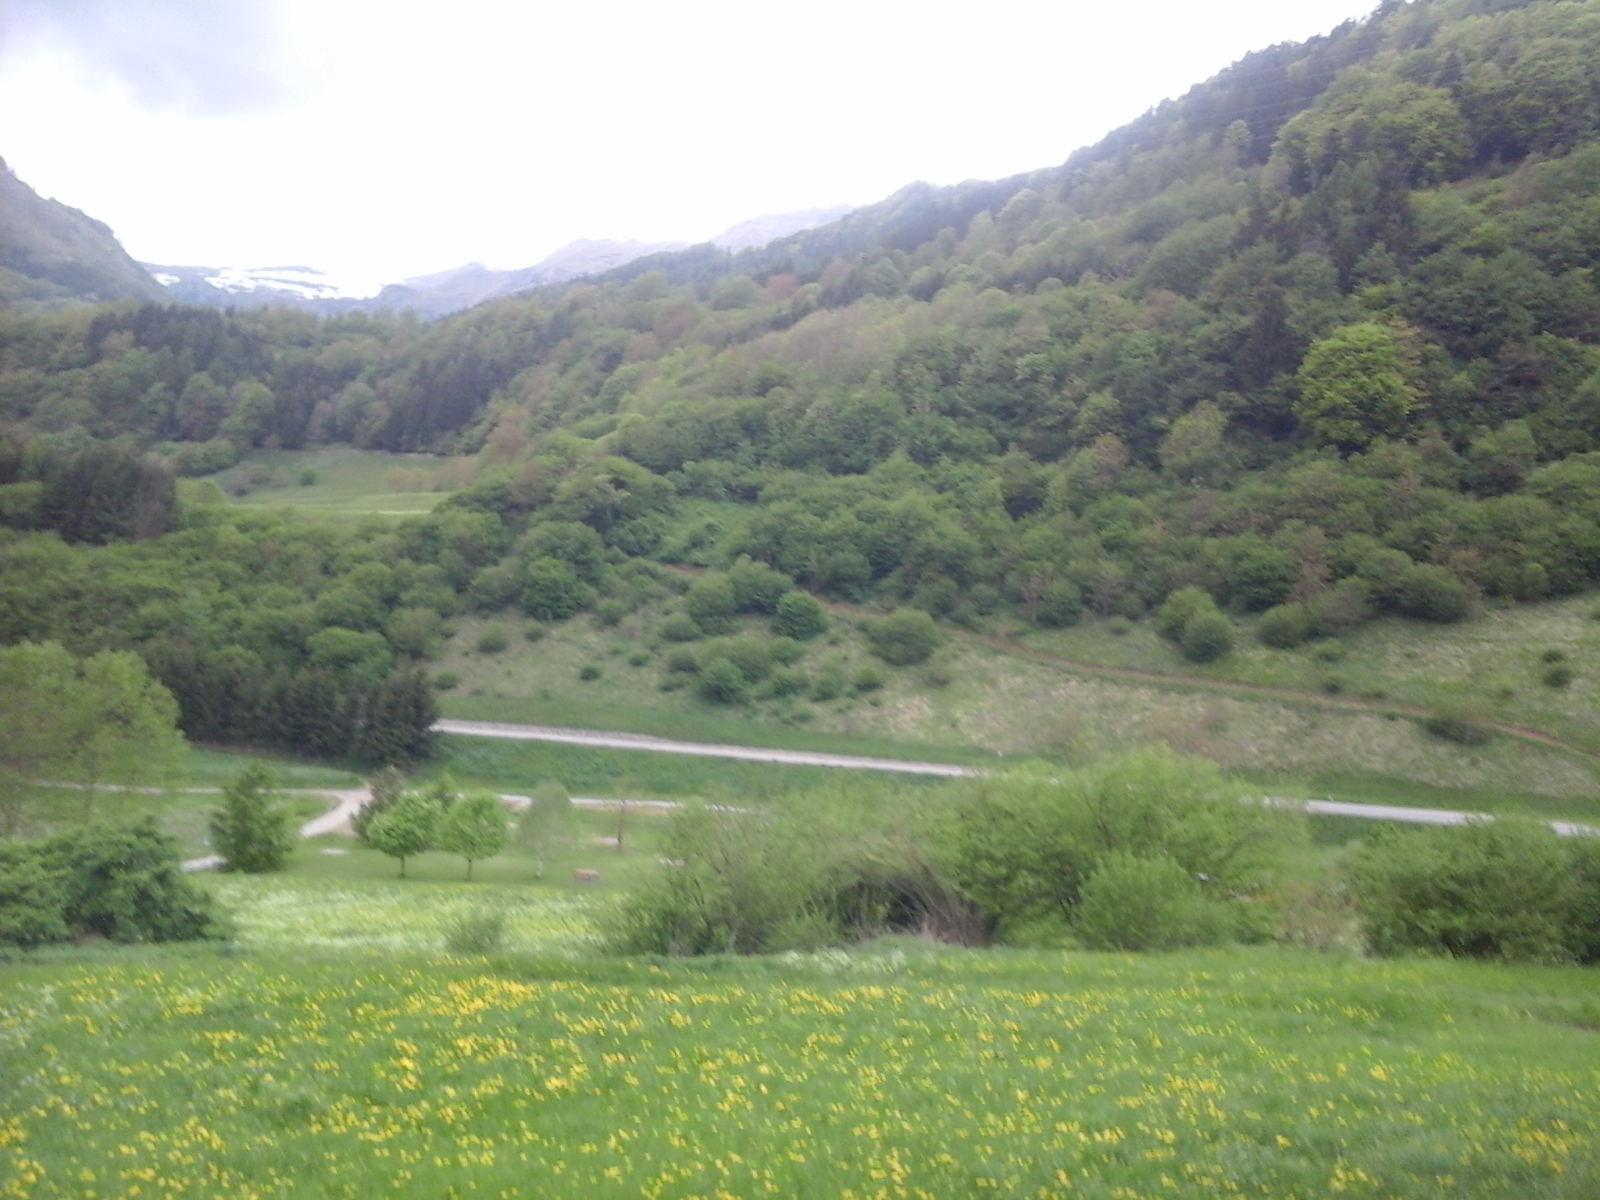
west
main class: Woodland
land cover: Spruce dominated mixed woodland
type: alpine coniferous forest
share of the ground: 25 - 50 %
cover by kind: coniferous forest trees 50 %, herbaceous plants 30 %, broadleaved forest trees 20 %
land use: Forestry
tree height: > 5 m
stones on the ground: > 50 %
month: May
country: IT
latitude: 45.9887
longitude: 10.6832
